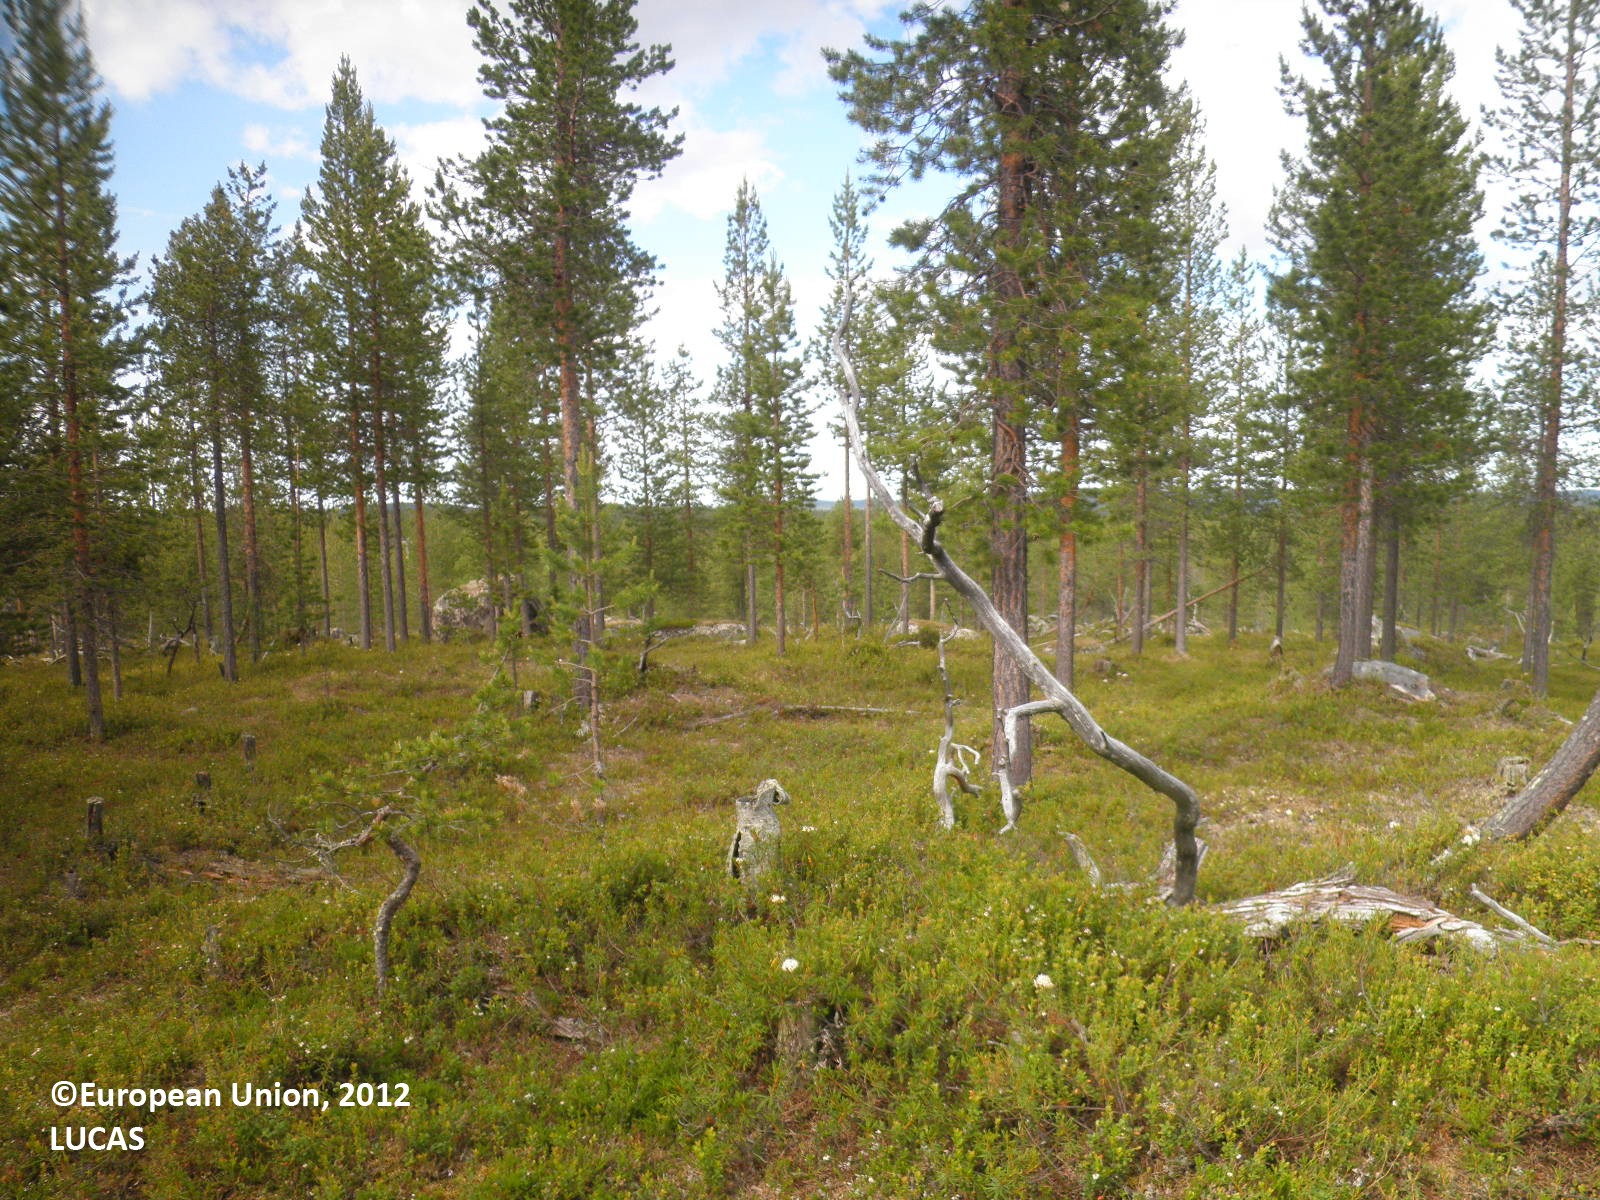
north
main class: Woodland
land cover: Pine dominated coniferous woodland
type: boreal forest
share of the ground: 25 - 50 %
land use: Forestry
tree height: > 5 m
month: July
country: FI
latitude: 68.6455
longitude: 27.8289
